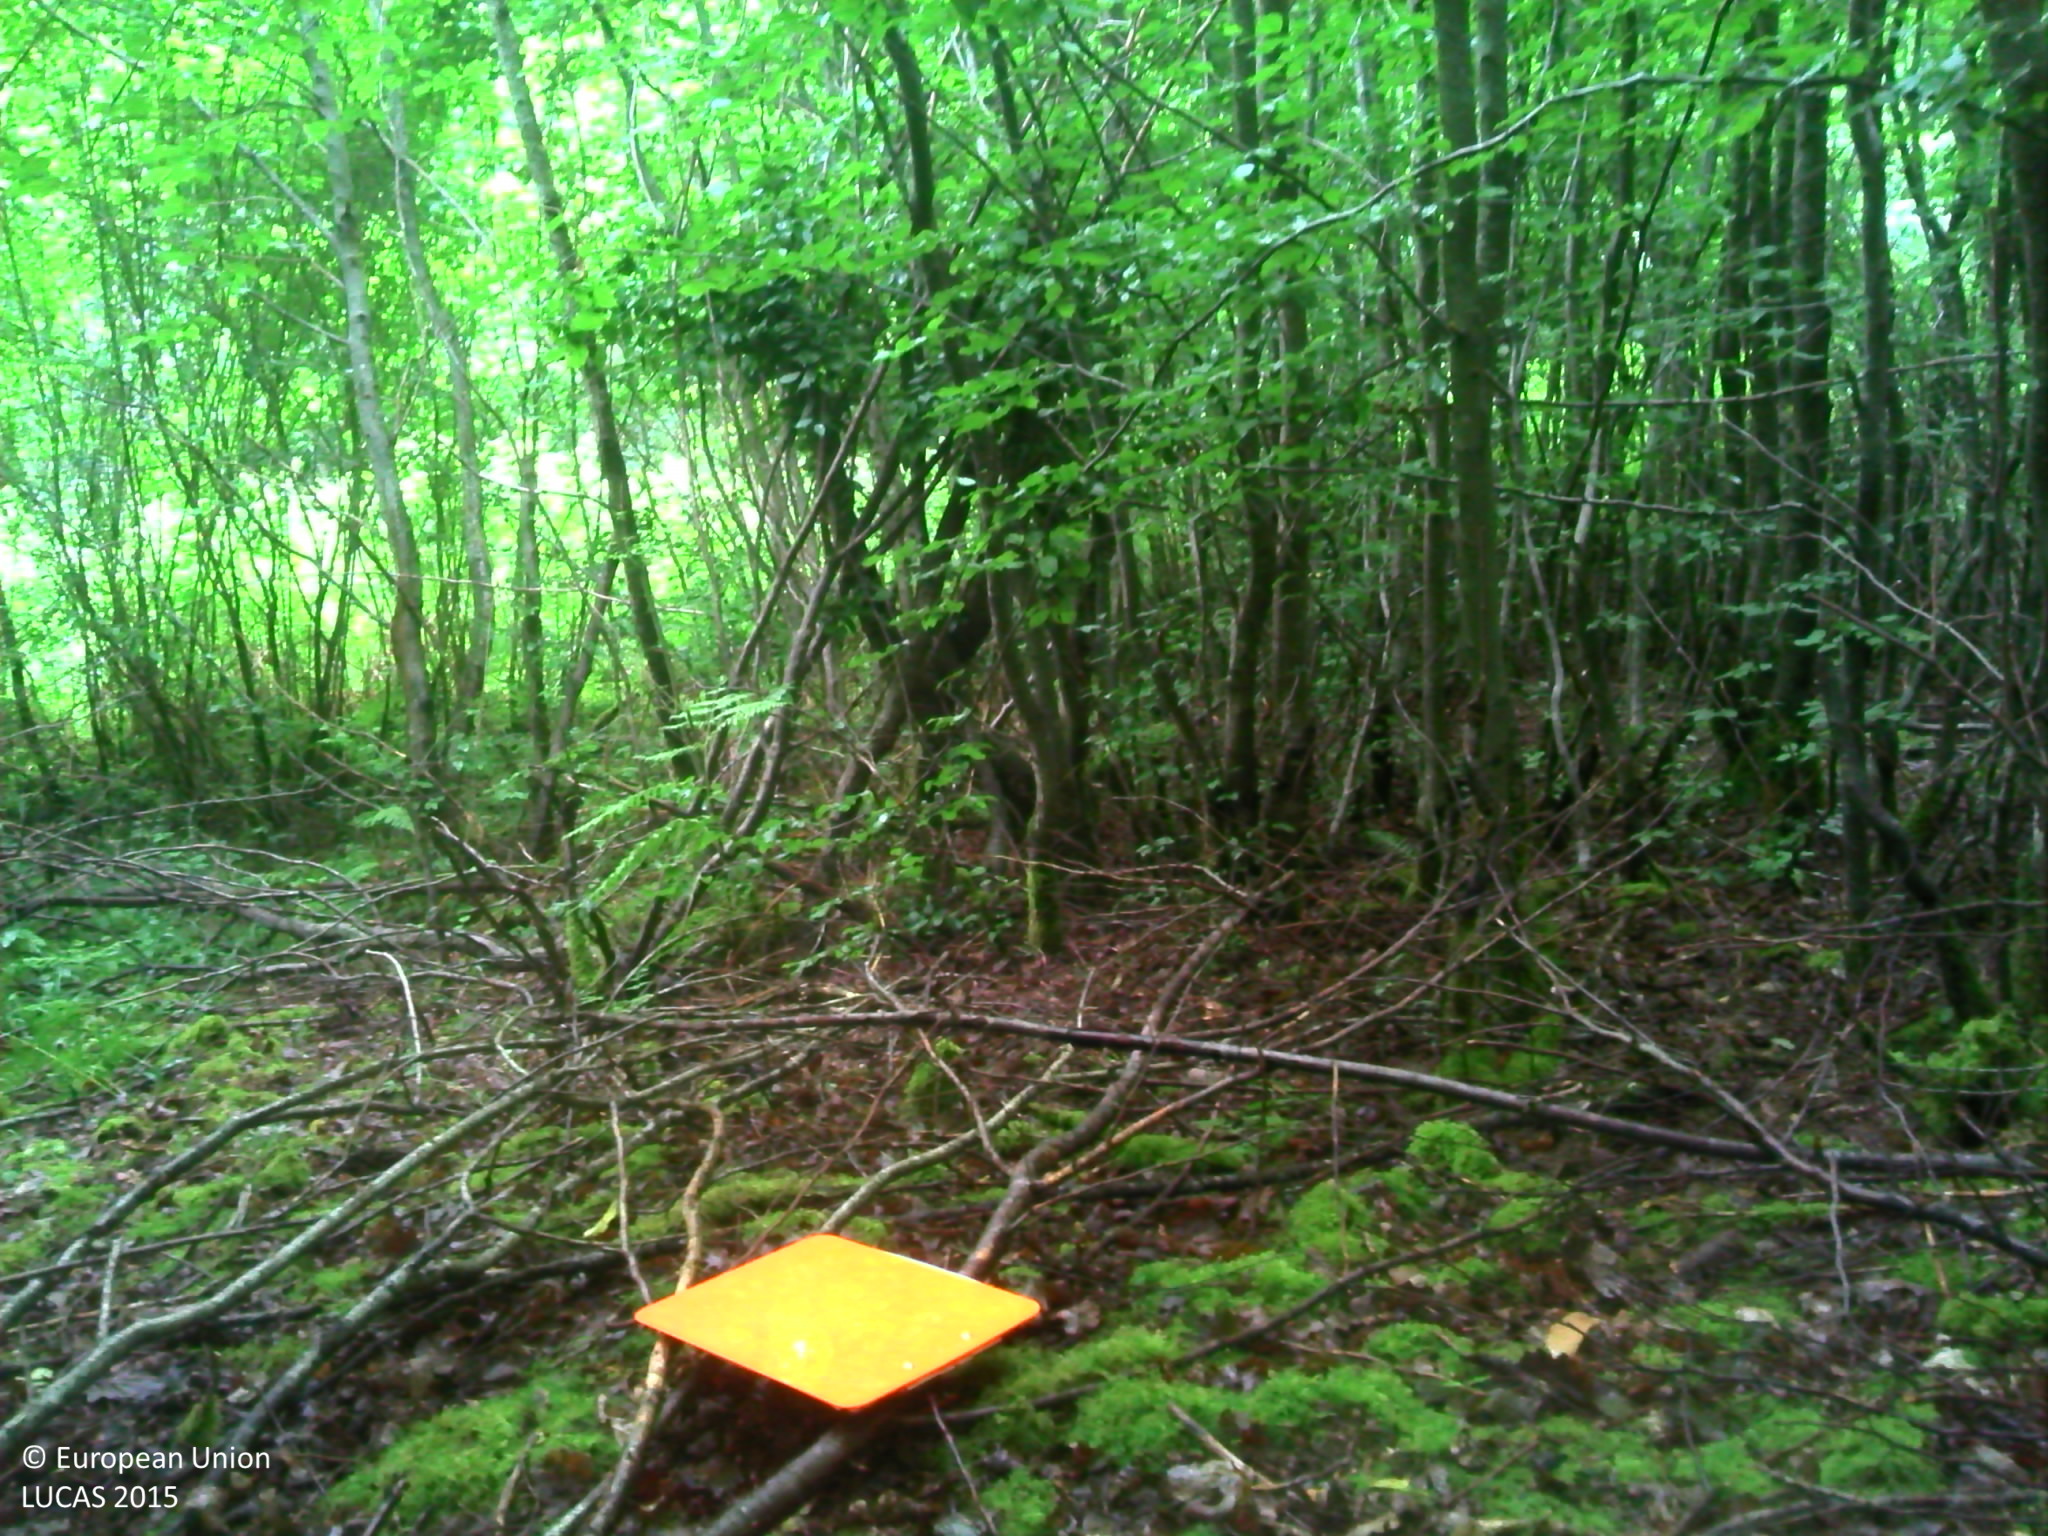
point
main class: Woodland
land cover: Broadleaved woodland
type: mesophytic deciduous forest
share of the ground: > 75 %
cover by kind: broadleaved forest trees 90 %, herbaceous plants 5 %, lichens and mosses 5 %
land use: Forestry
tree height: > 5 m
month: June
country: FR
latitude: 47.3065
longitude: 3.1572
